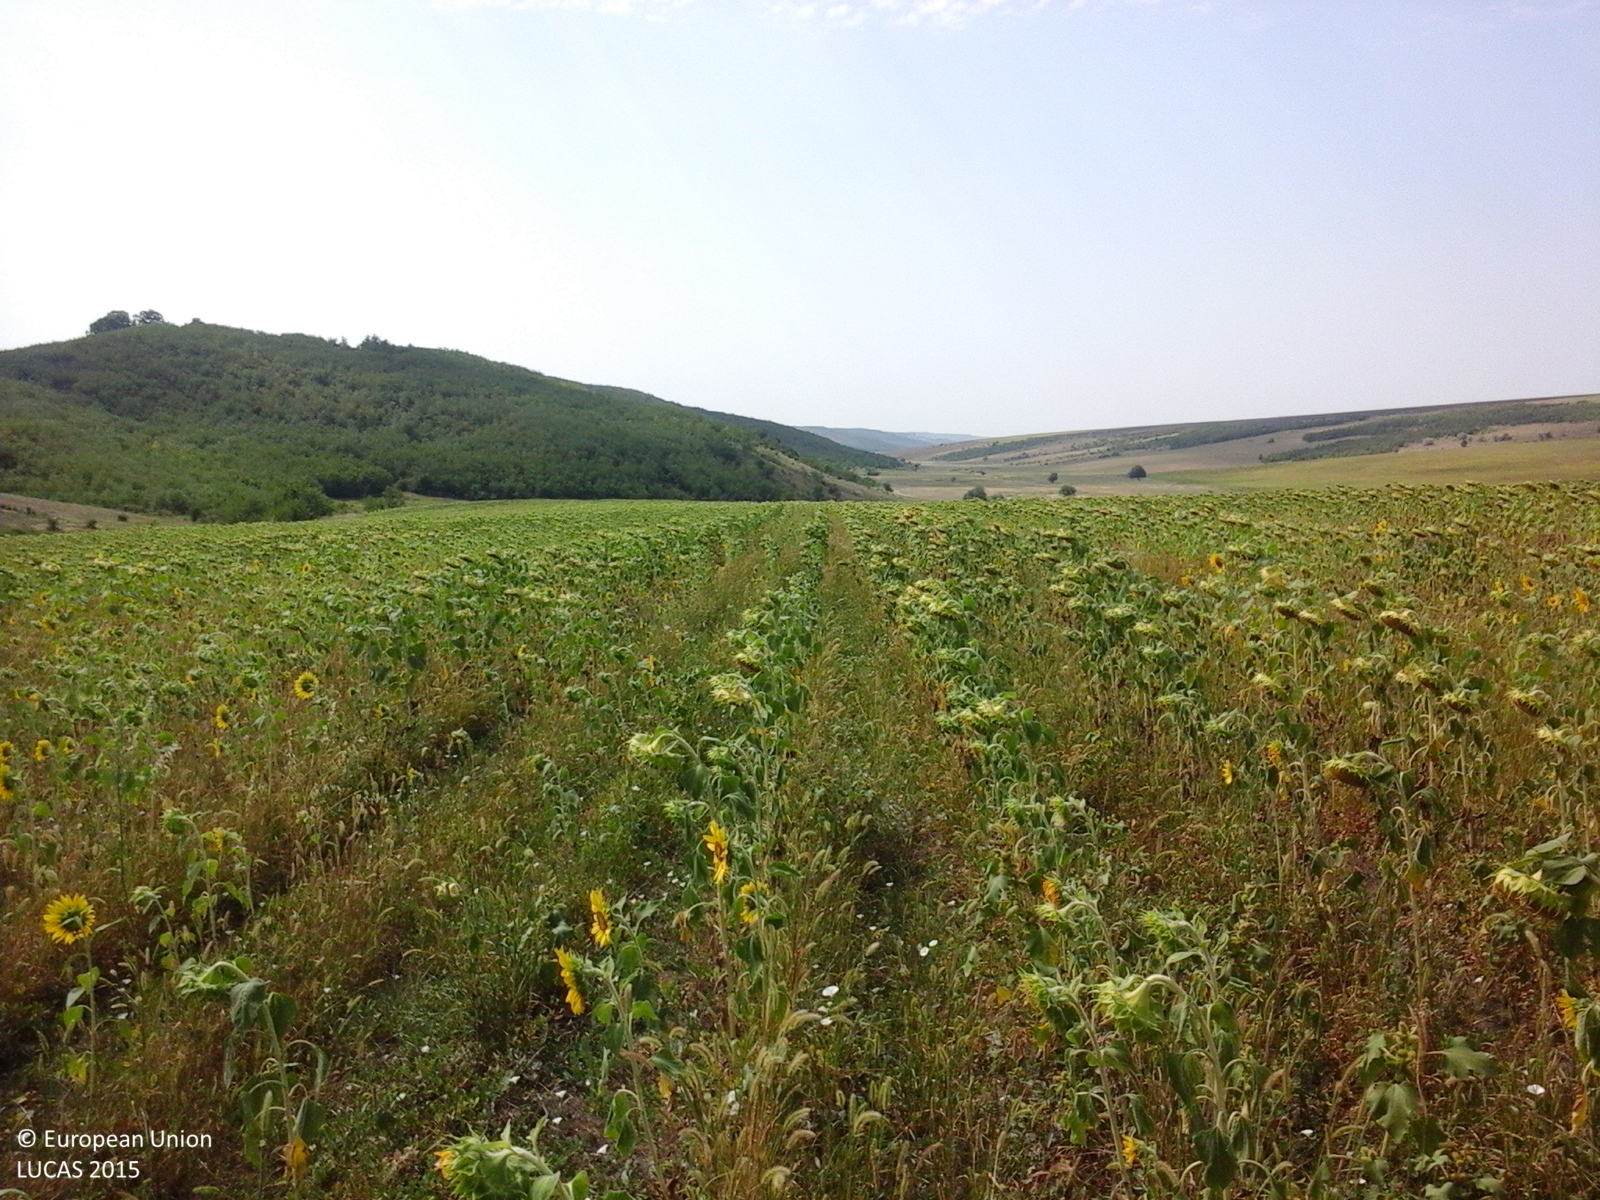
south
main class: Cropland
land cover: Sunflower
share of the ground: 50 - 75 %
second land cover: Spontaneously vegetated surfaces
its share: 25 - 50 %
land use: Agriculture (excluding fallow land and kitchen gardens)
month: July
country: RO
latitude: 46.0309
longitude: 27.9633
